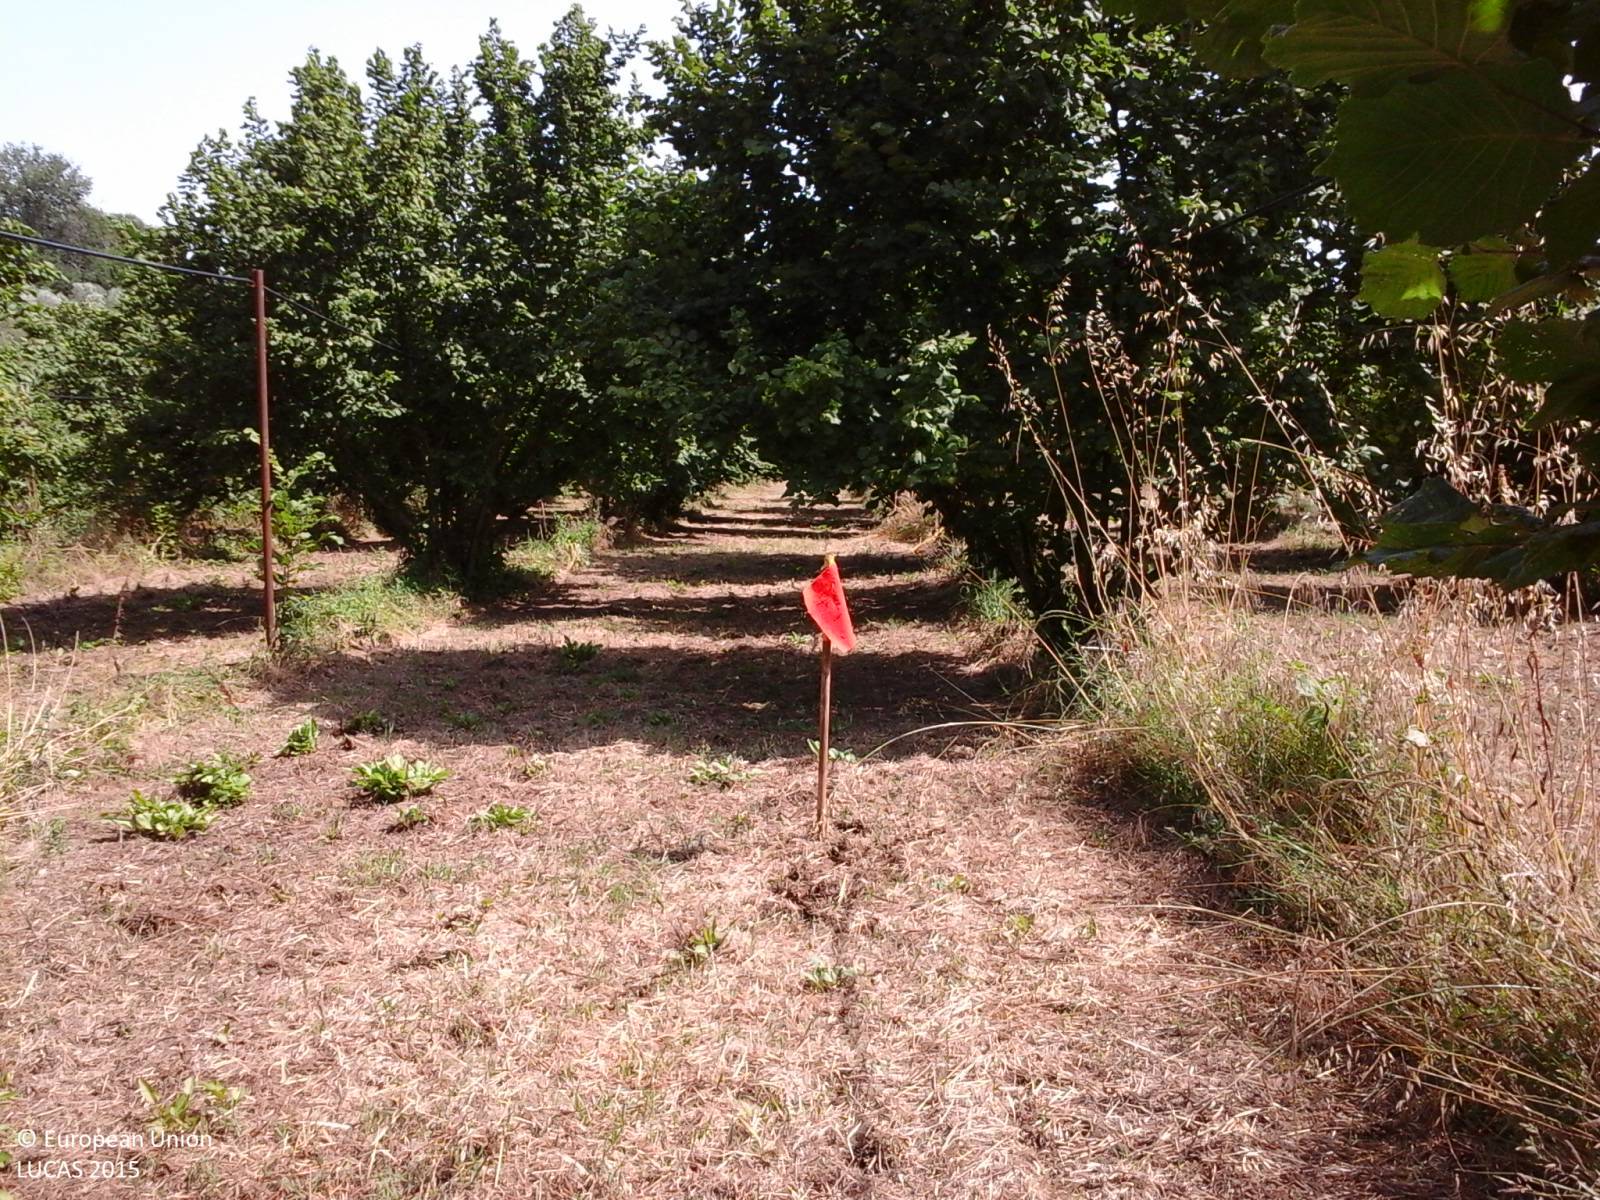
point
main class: Cropland
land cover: Nuts trees
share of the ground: > 75 %
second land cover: Grassland without tree/shrub cover
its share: > 75 %
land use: Agriculture (excluding fallow land and kitchen gardens)
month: June
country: IT
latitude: 42.4305
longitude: 12.2411
